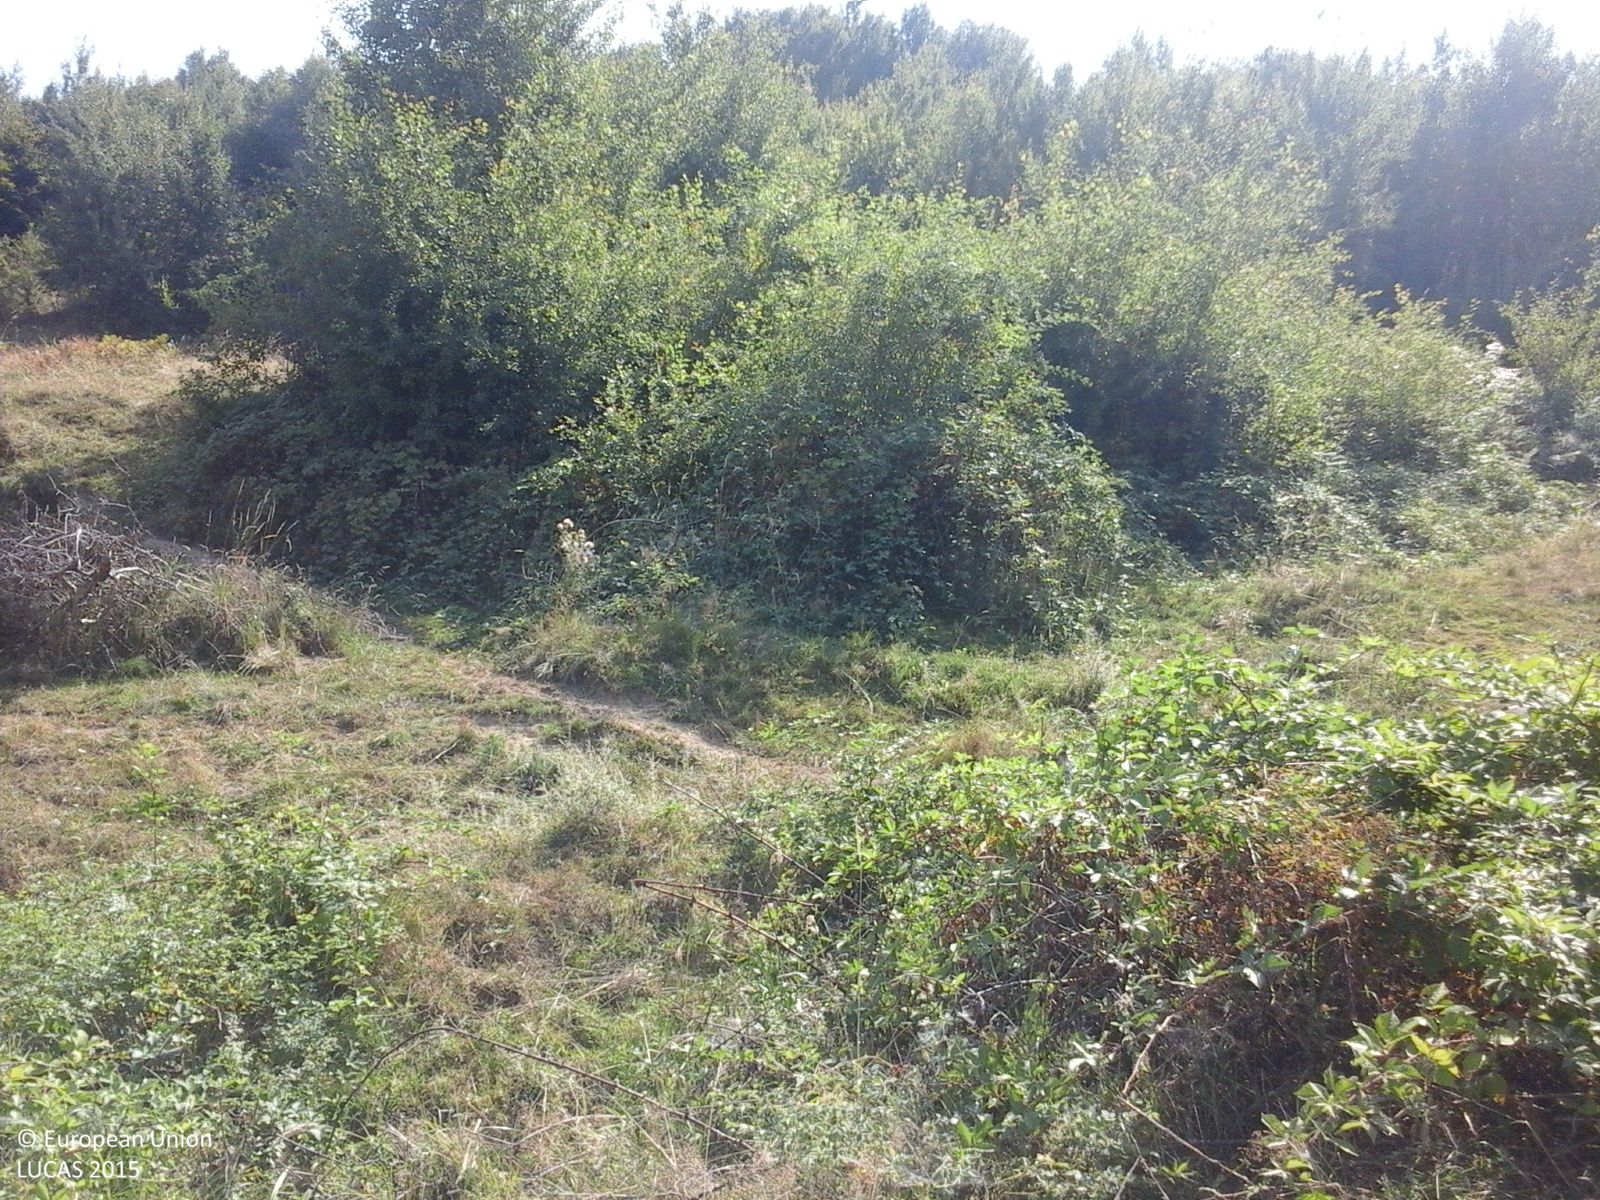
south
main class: Grassland
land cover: Grassland with sparse tree/shrub cover
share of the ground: > 75 %
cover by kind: herbaceous plants 85 %, shrubs 10 %, broadleaved forest trees 5 %
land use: Agriculture (excluding fallow land and kitchen gardens)
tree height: > 5 m
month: September
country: RO
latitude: 47.0520
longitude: 24.1289
